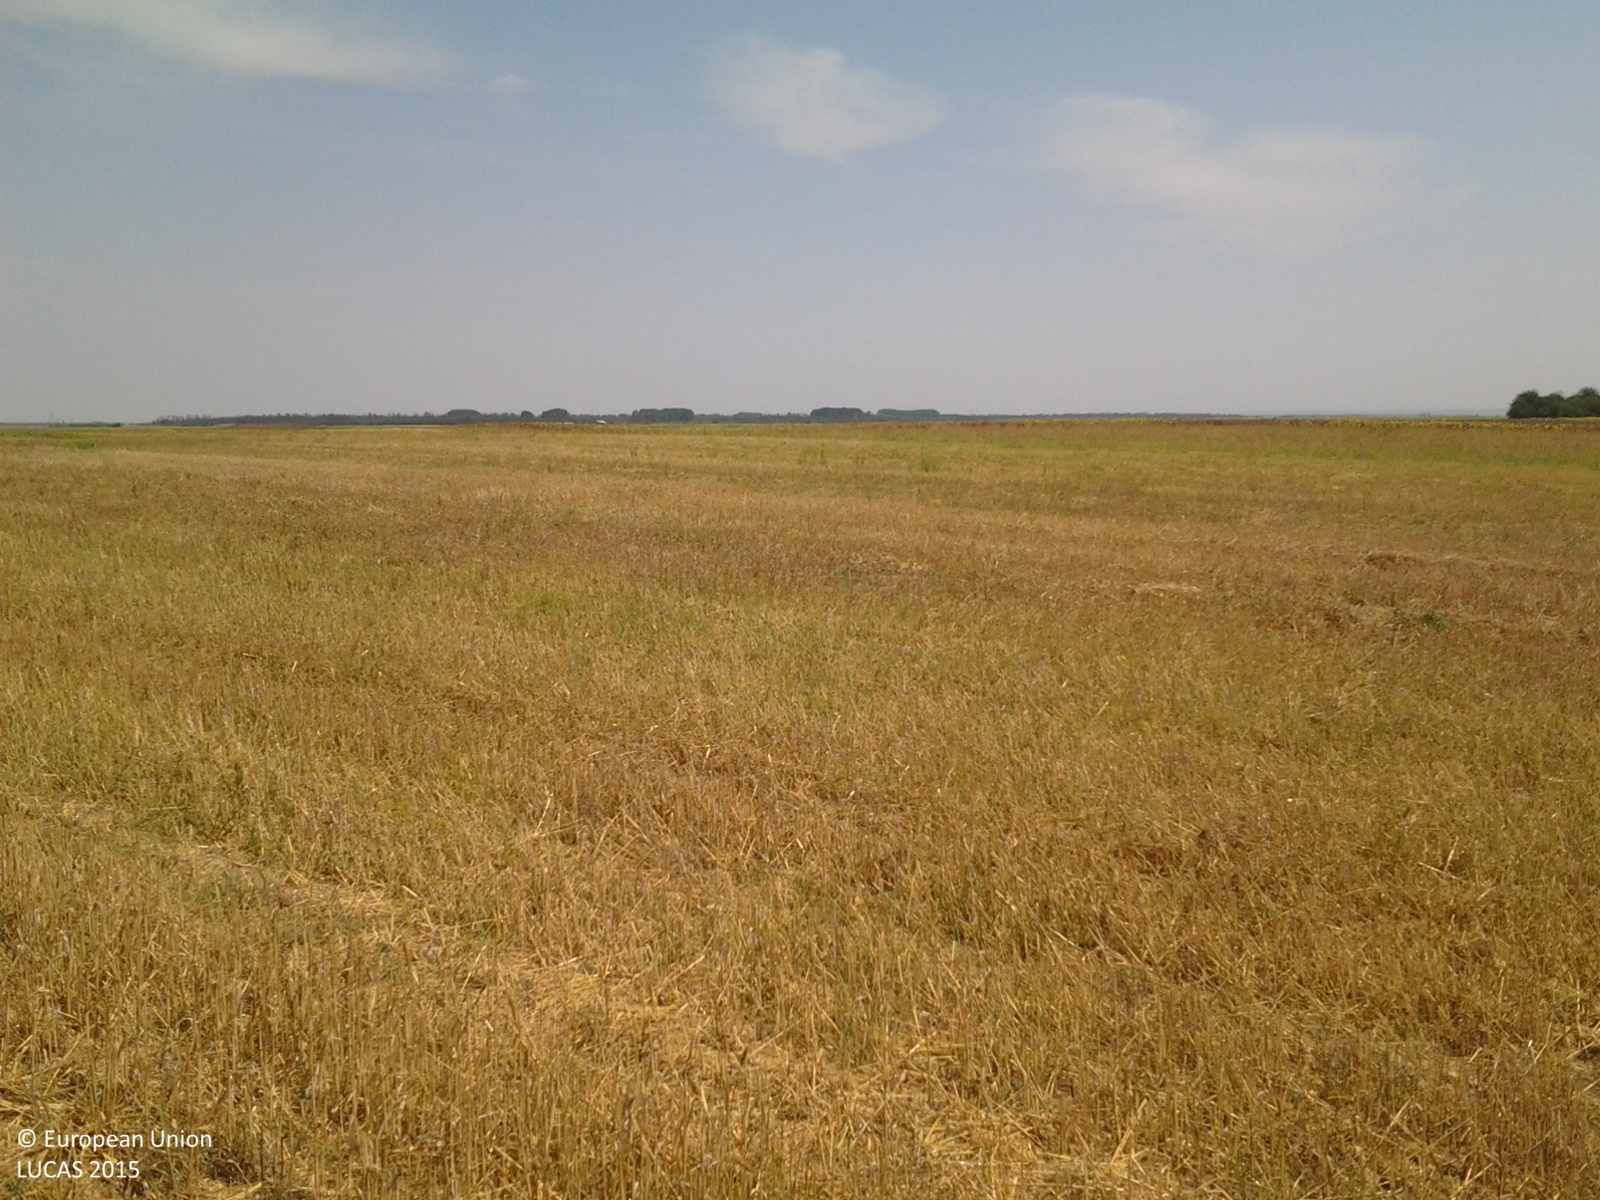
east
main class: Cropland
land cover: Common wheat
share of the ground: 50 - 75 %
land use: Agriculture (excluding fallow land and kitchen gardens)
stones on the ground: < 10 %
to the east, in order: Common wheat; Sunflower; Common wheat
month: August
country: RO
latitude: 43.8678
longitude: 22.9179
